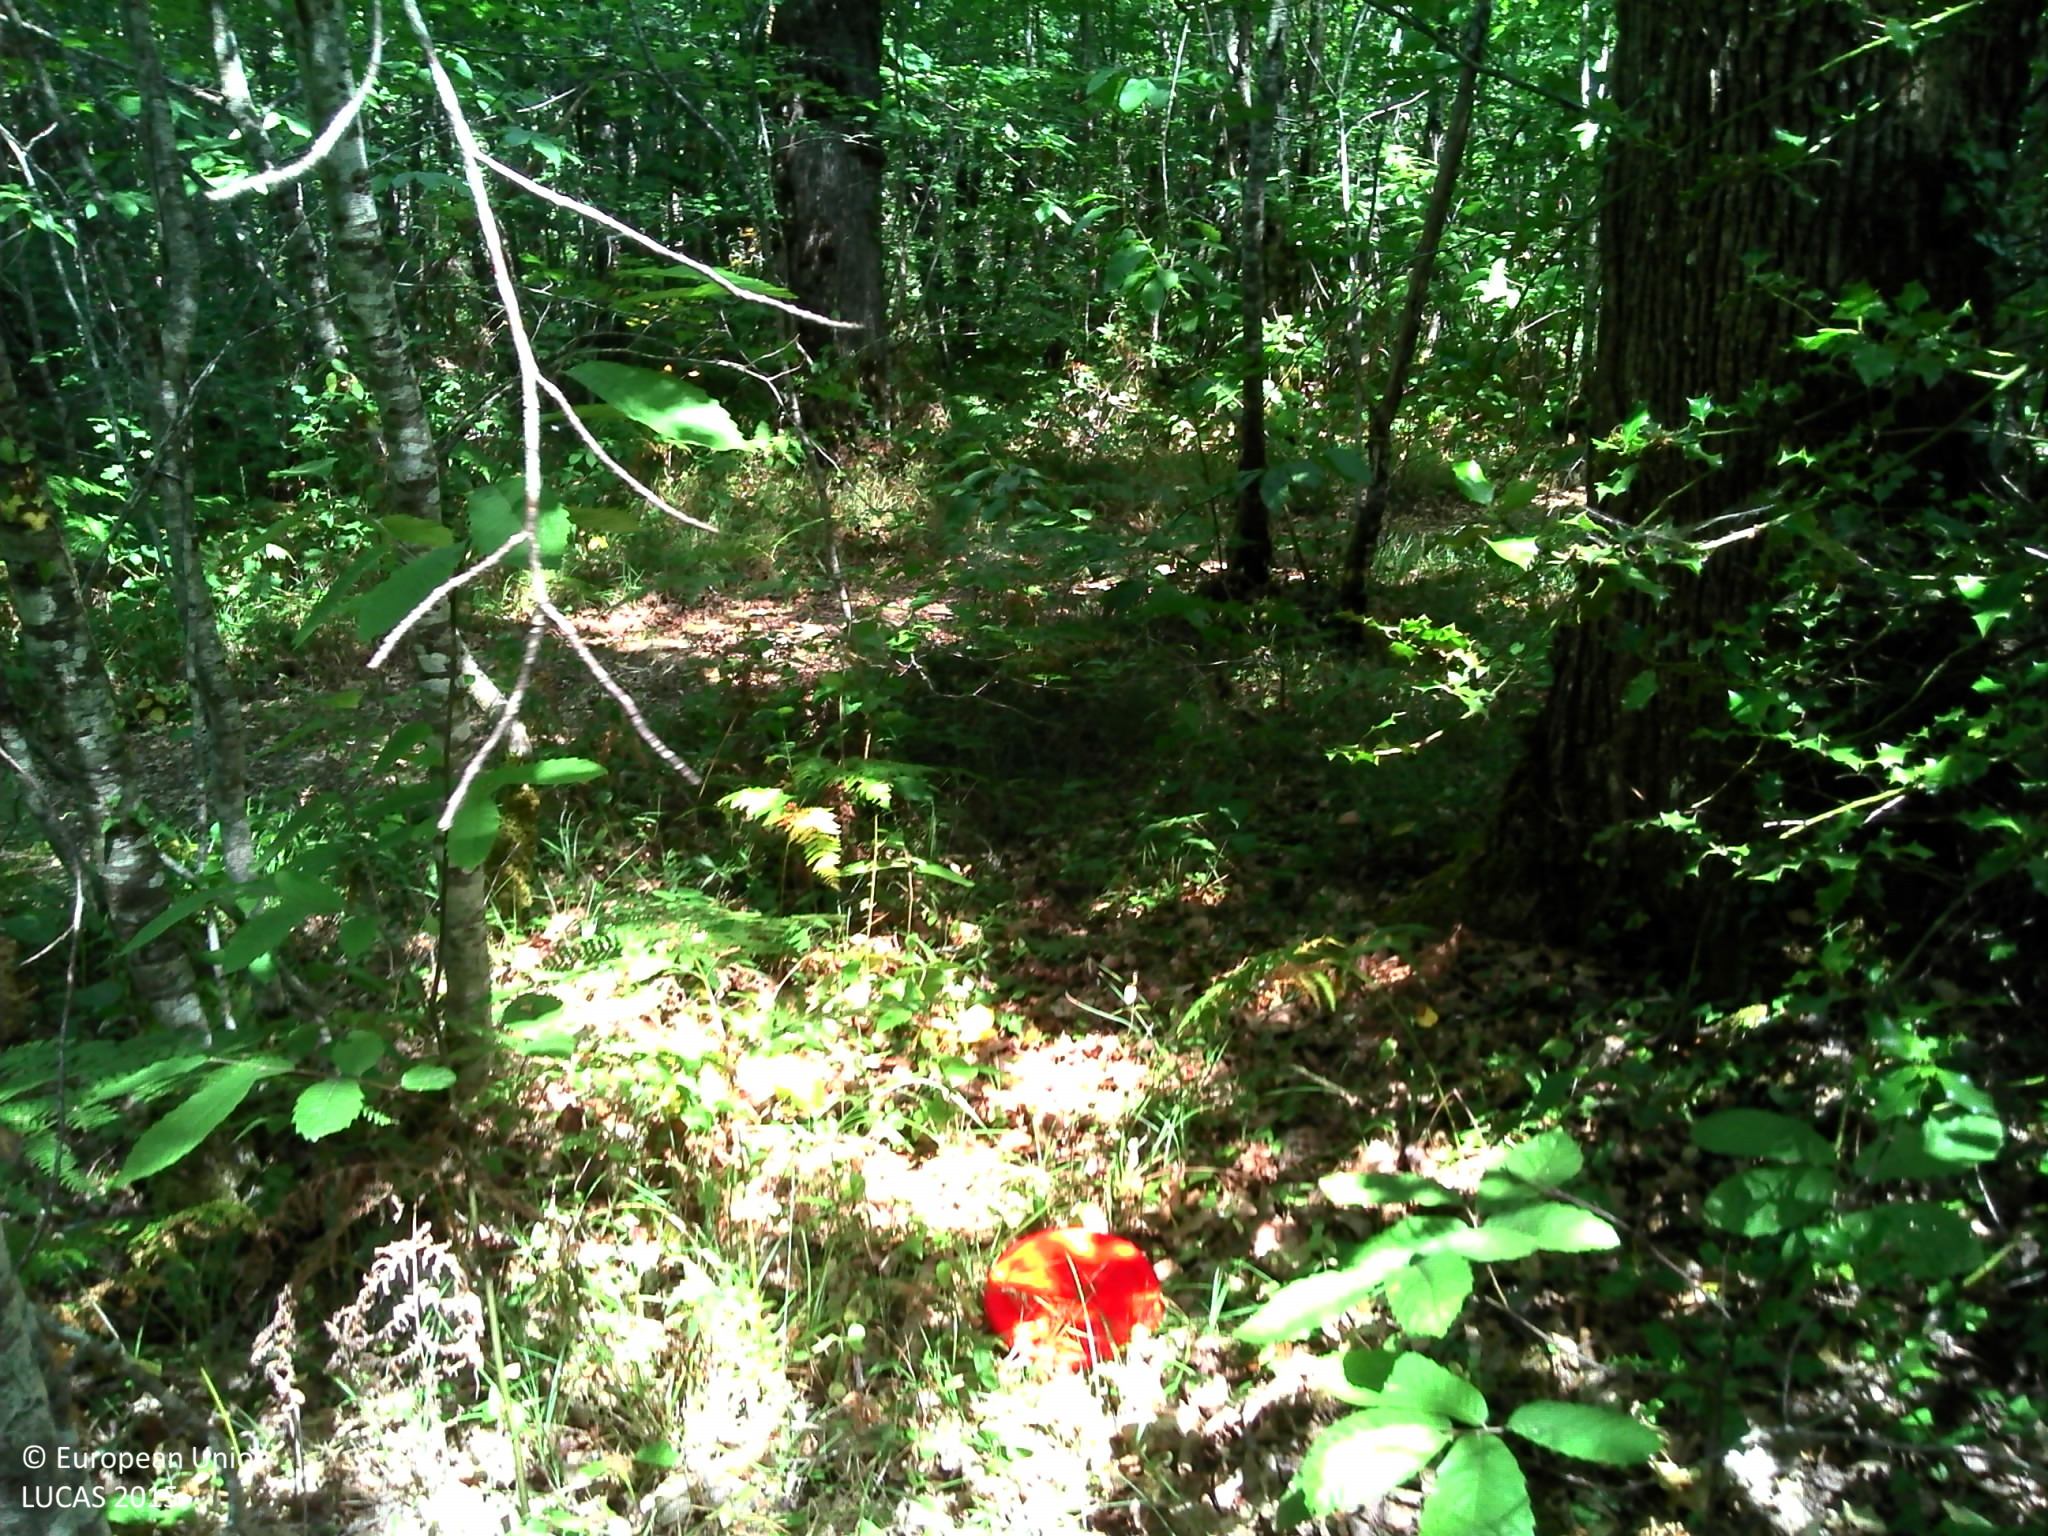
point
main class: Woodland
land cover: Broadleaved woodland
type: thermophilous deciduous forest
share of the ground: > 75 %
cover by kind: broadleaved forest trees 75 %, herbaceous plants 15 %, shrubs 10 %
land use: Forestry
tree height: > 5 m
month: July
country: FR
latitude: 45.1737
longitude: 0.7910
